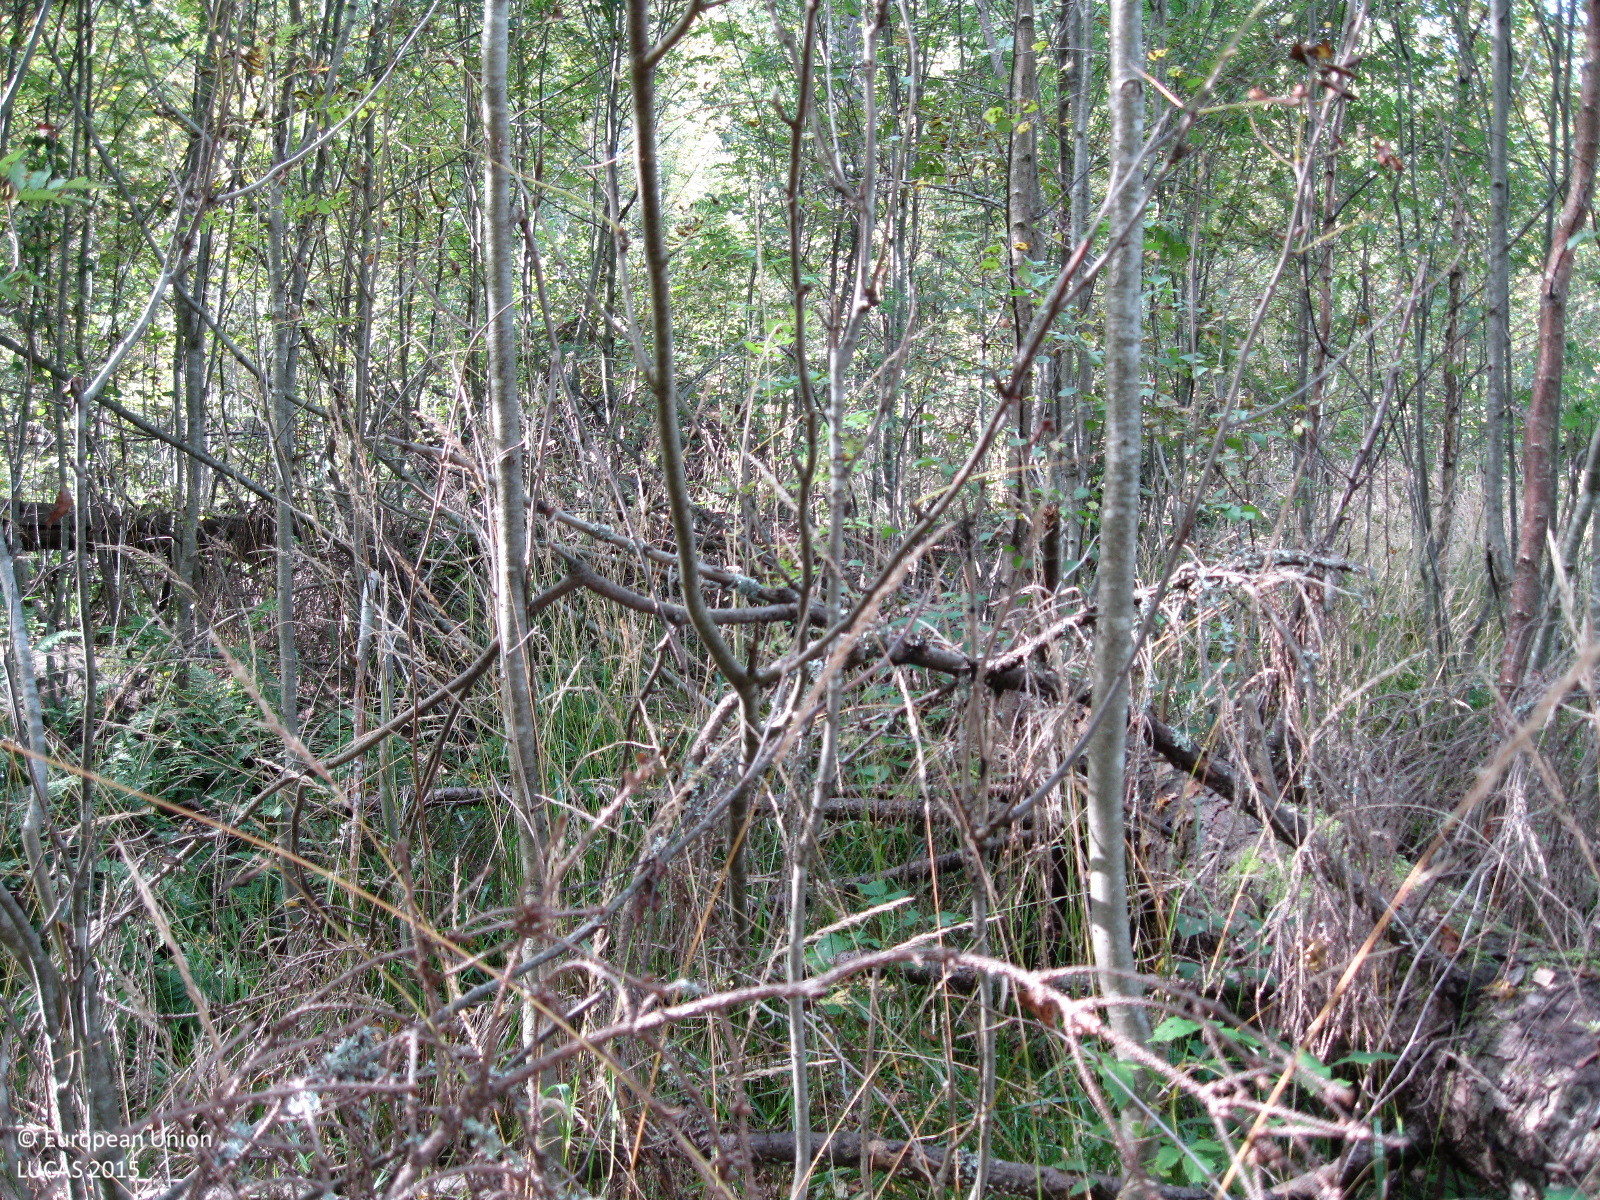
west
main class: Woodland
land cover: Broadleaved woodland
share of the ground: > 75 %
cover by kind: broadleaved forest trees 90 %, shrubs 5 %, herbaceous plants 5 %
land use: Forestry
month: September
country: FI
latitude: 60.3773
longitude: 24.5267
